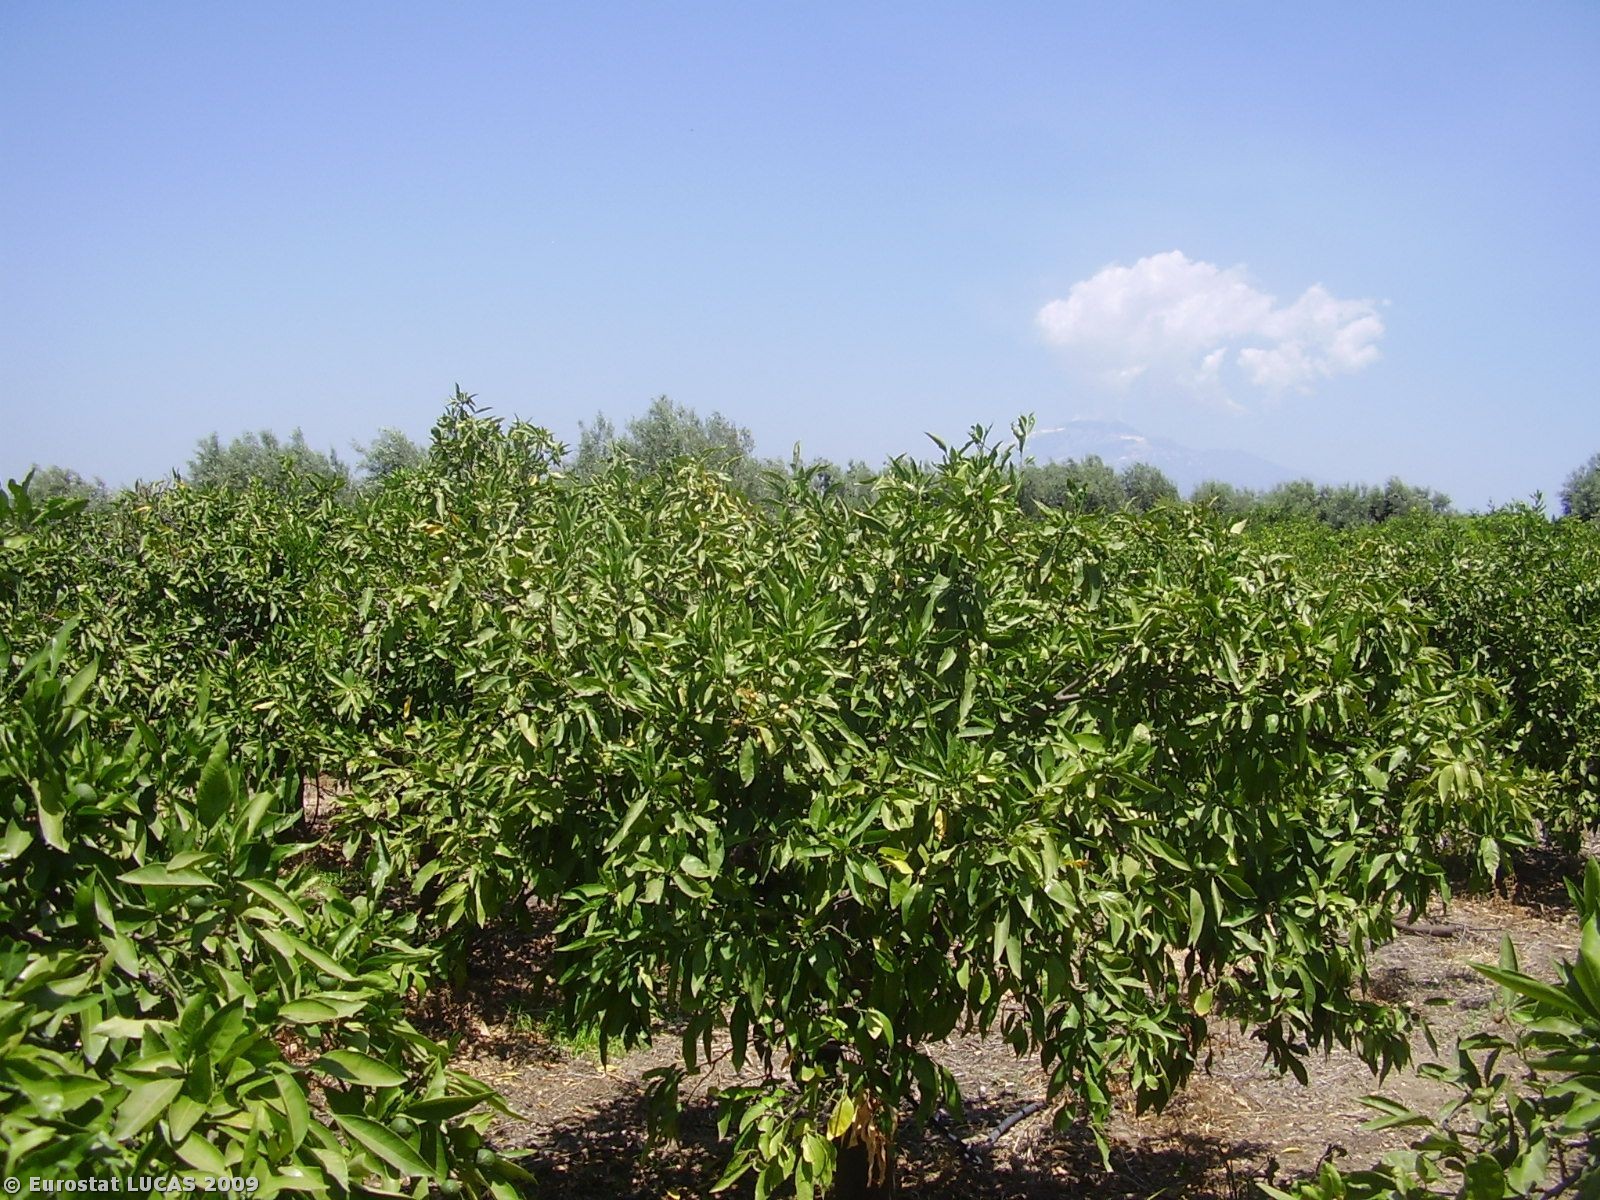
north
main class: Cropland
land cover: Oranges
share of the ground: 25 - 50 %
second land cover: Bare land
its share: > 75 %
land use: Agriculture (excluding fallow land and kitchen gardens)
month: June
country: IT
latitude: 37.5117
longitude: 14.9085
